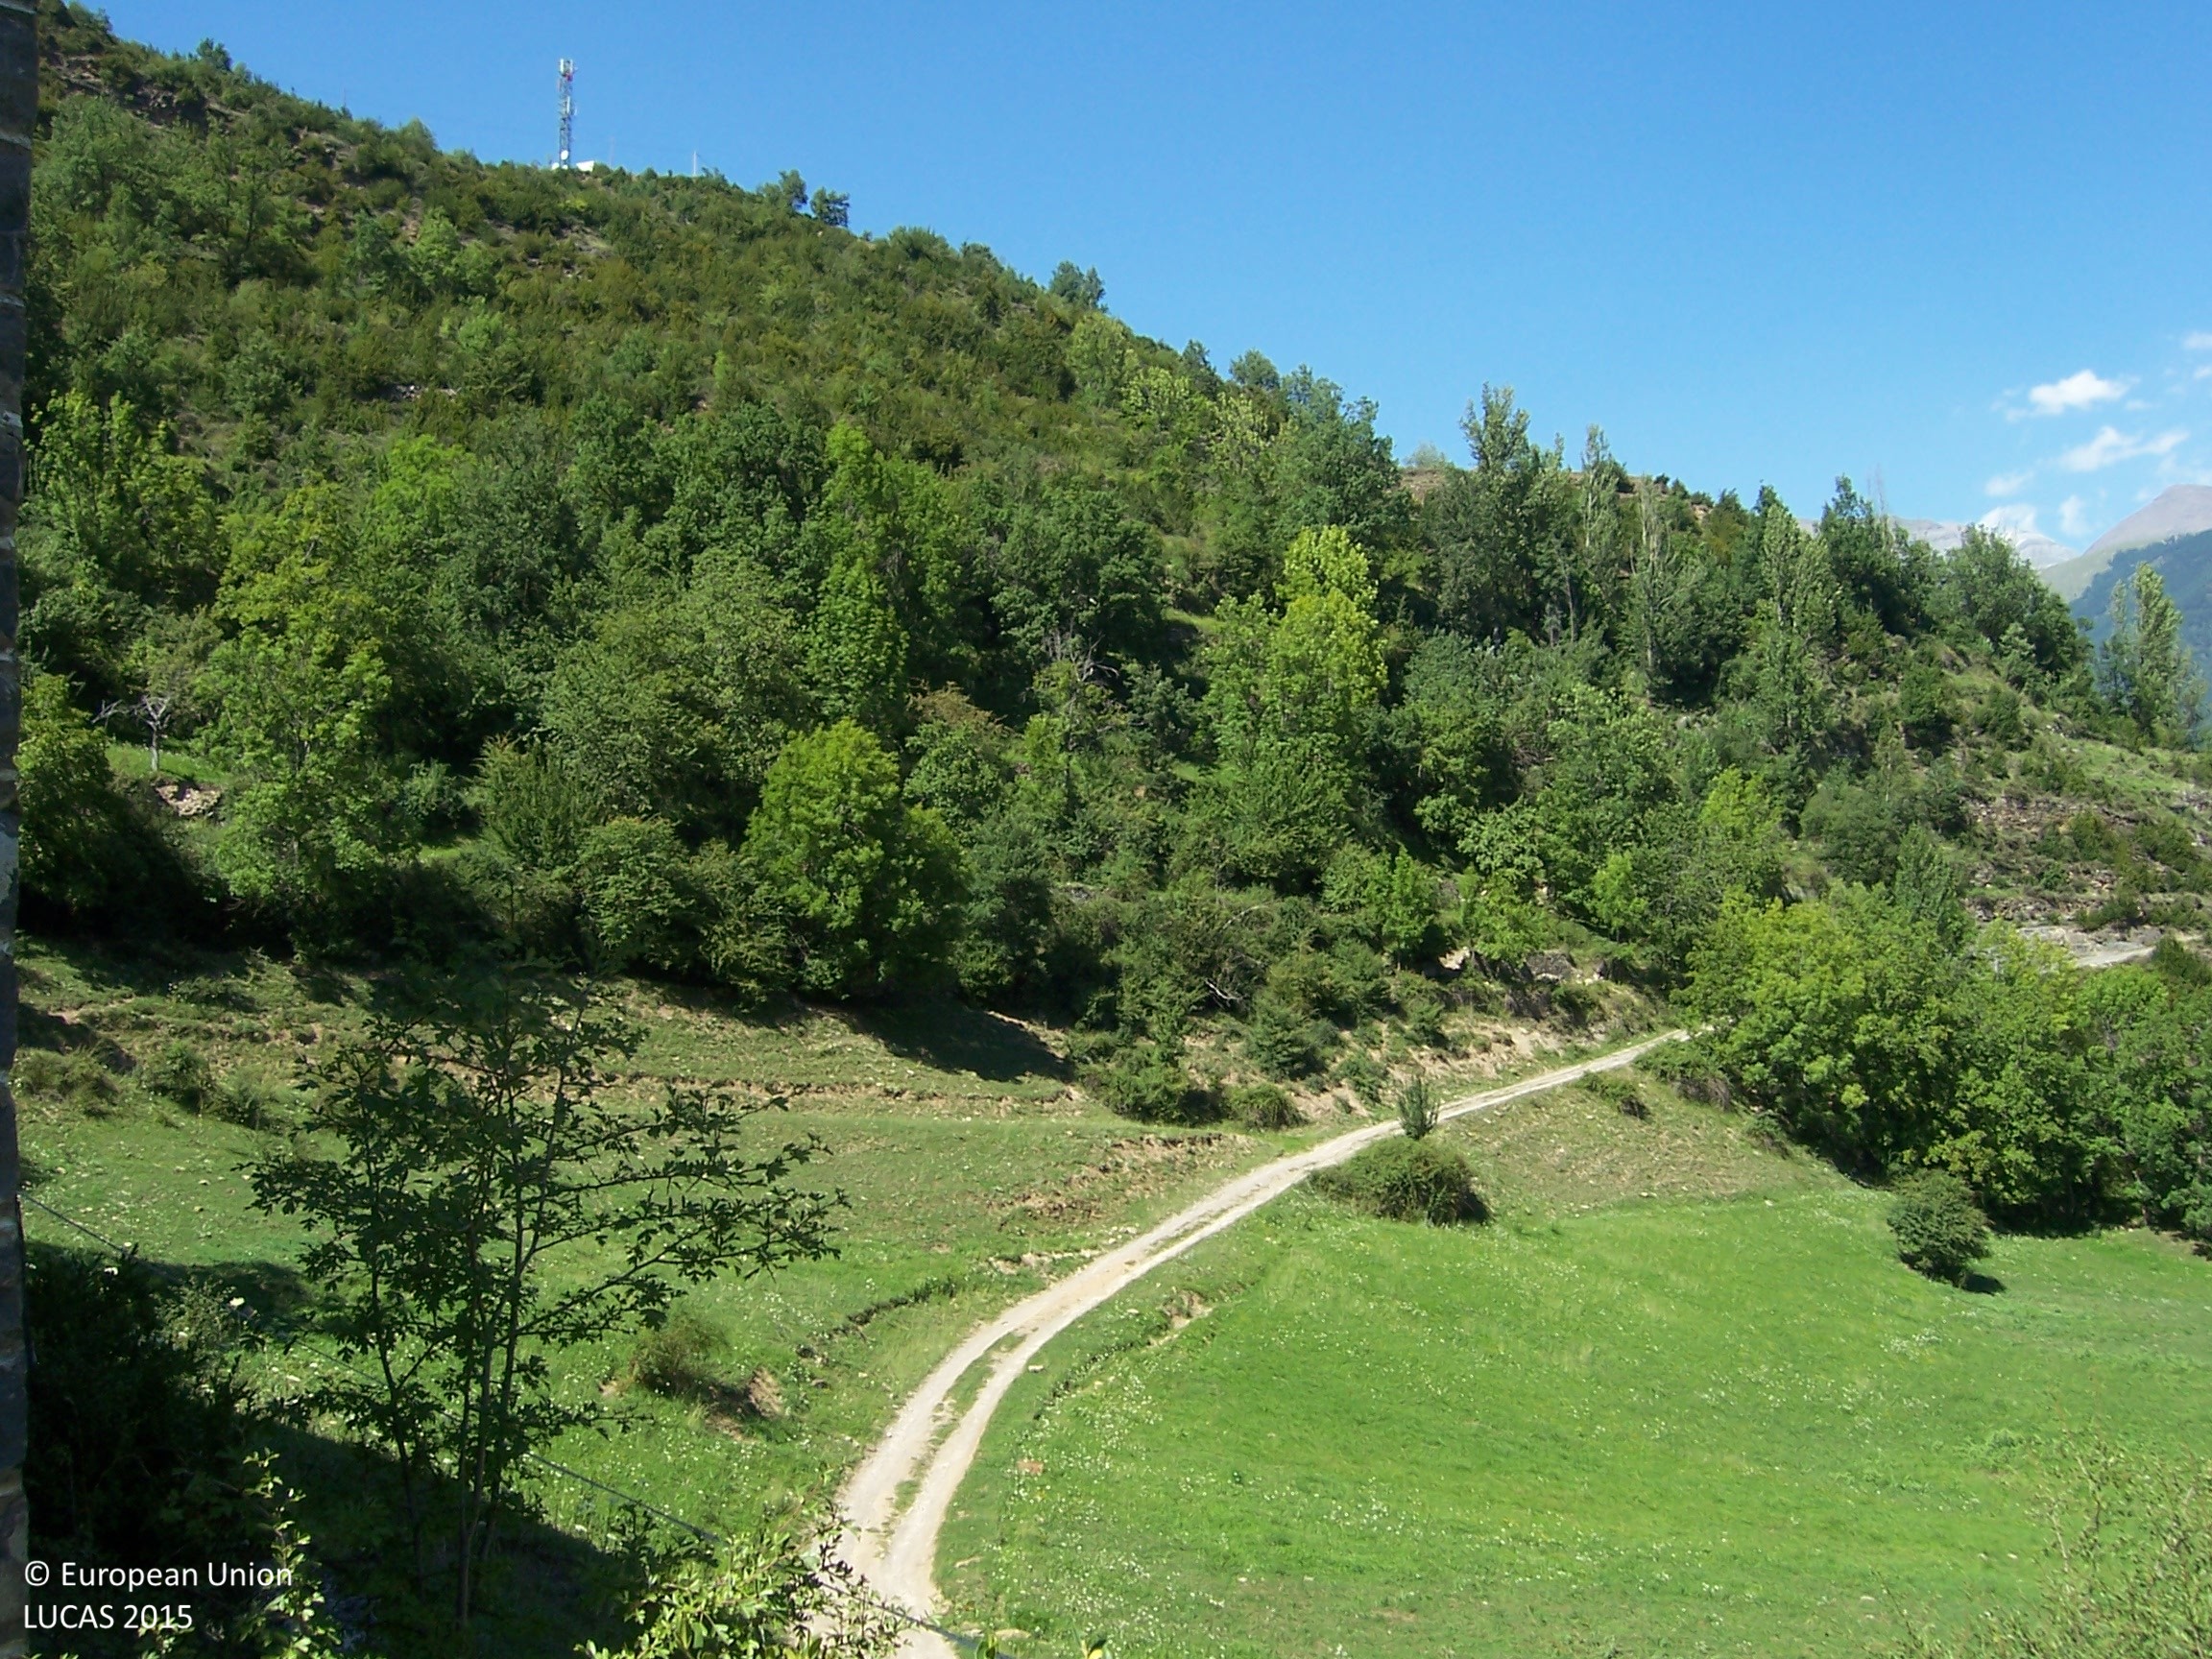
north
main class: Grassland
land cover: Grassland with sparse tree/shrub cover
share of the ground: > 75 %
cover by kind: herbaceous plants 95 %, broadleaved forest trees 5 %
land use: Semi-natural and natural areas not in use
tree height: > 5 m
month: August
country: ES
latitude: 42.5997
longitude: -0.1281
